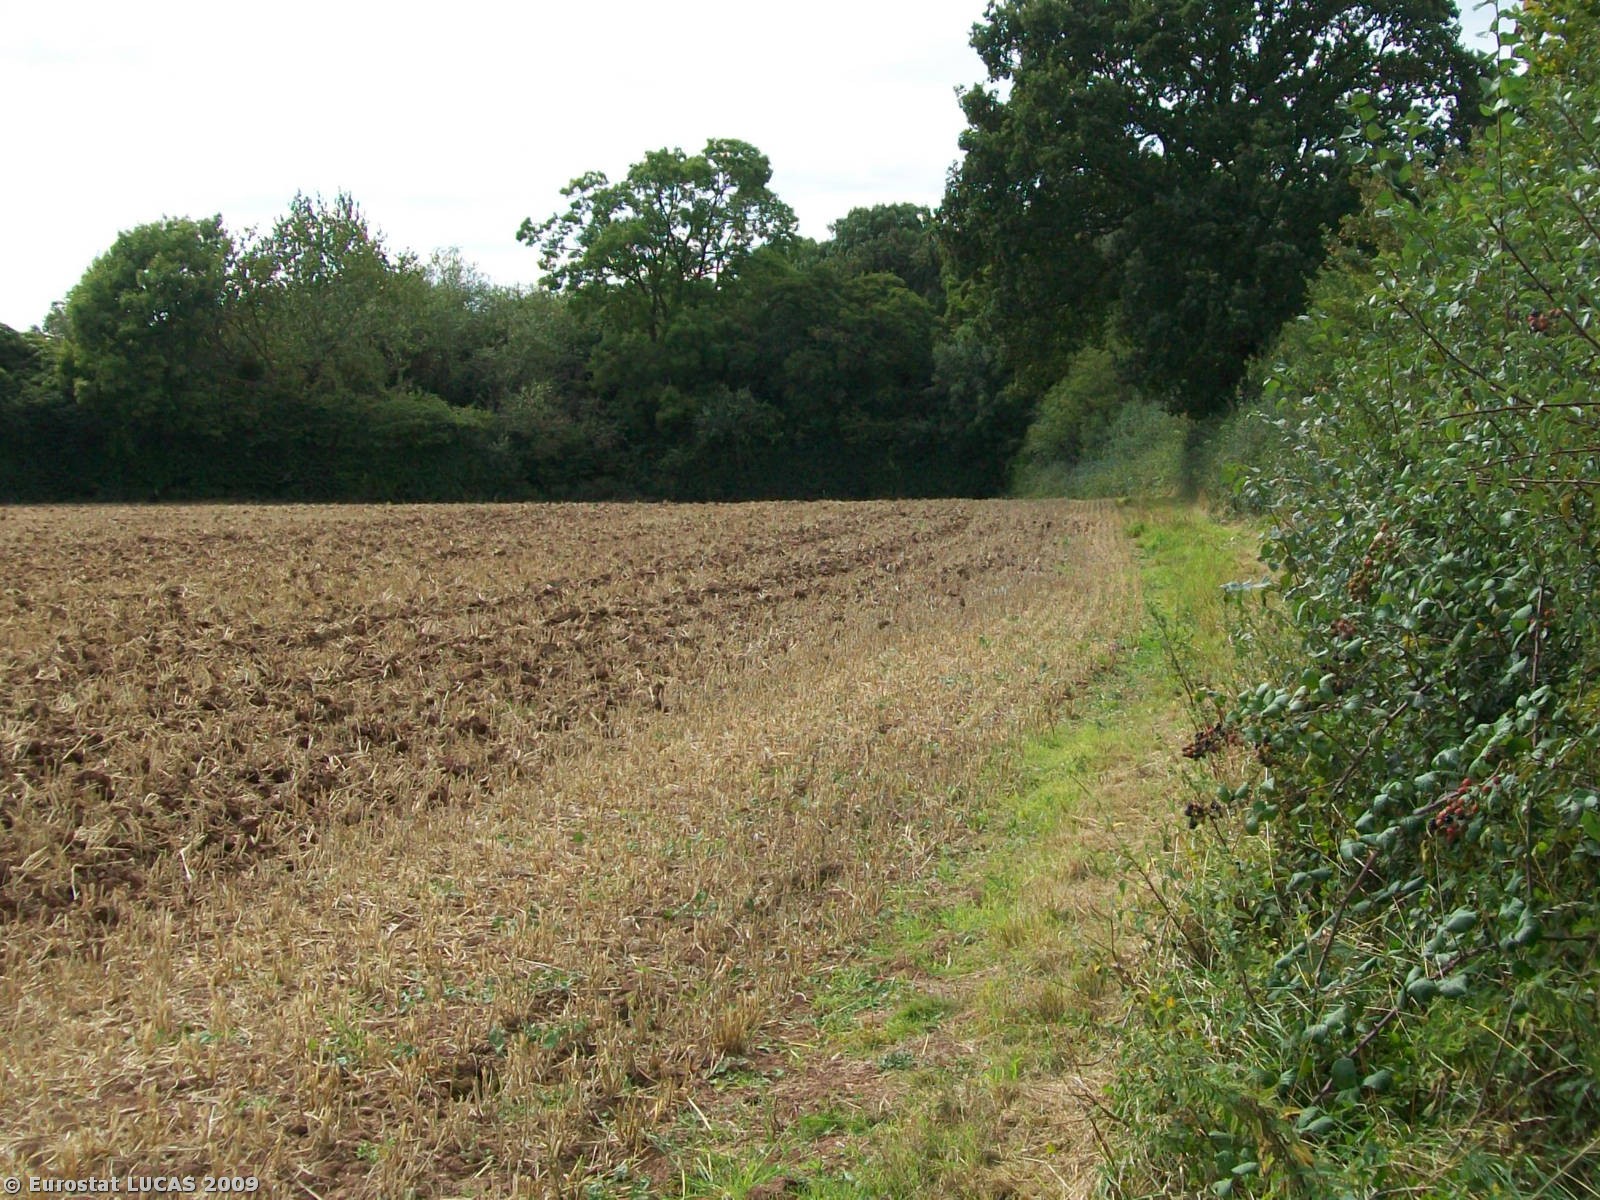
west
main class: Cropland
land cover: Common wheat
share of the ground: < 10 %
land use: Agriculture (excluding fallow land and kitchen gardens)
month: August
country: GB
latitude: 51.8733
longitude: -2.3667
